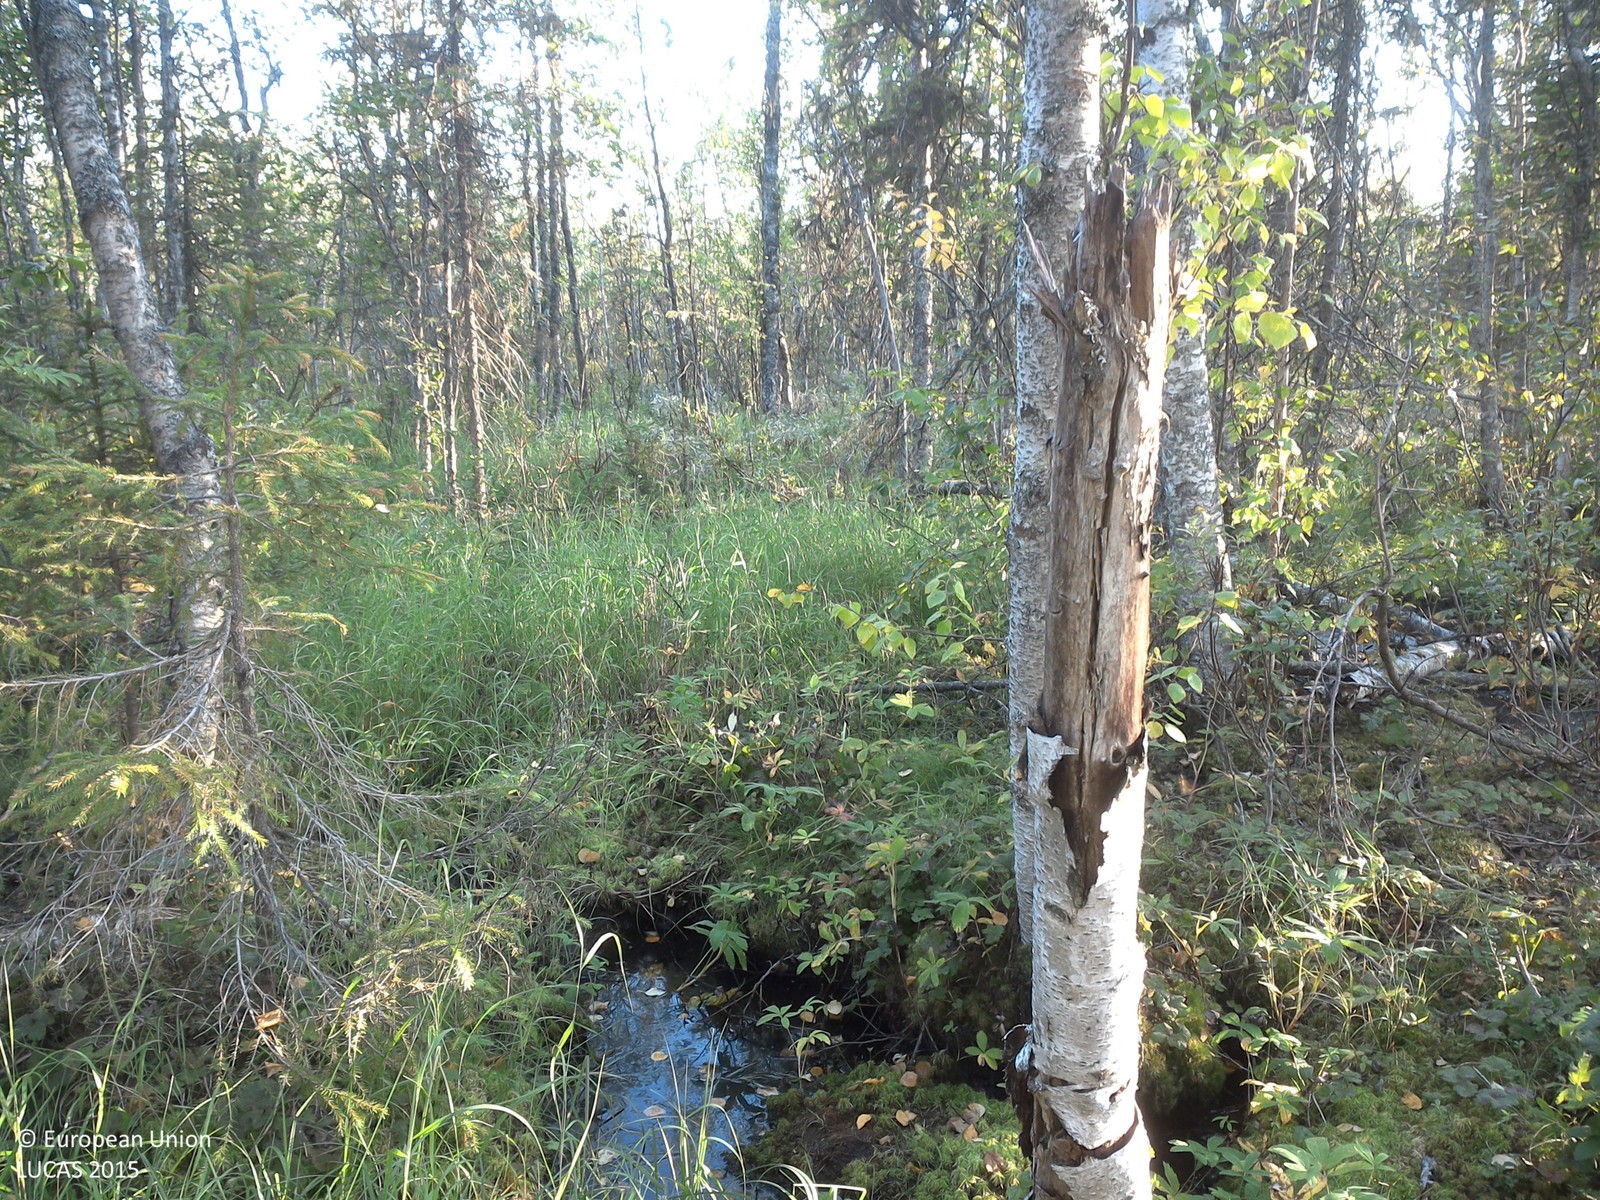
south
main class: Woodland
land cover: Other mixed woodland
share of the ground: 25 - 50 %
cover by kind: herbaceous plants 40 %, broadleaved forest trees 25 %, coniferous forest trees 15 %, lichens and mosses 15 %, shrubs 5 %
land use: Forestry
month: August
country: SE
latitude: 67.1313
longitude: 22.5305
